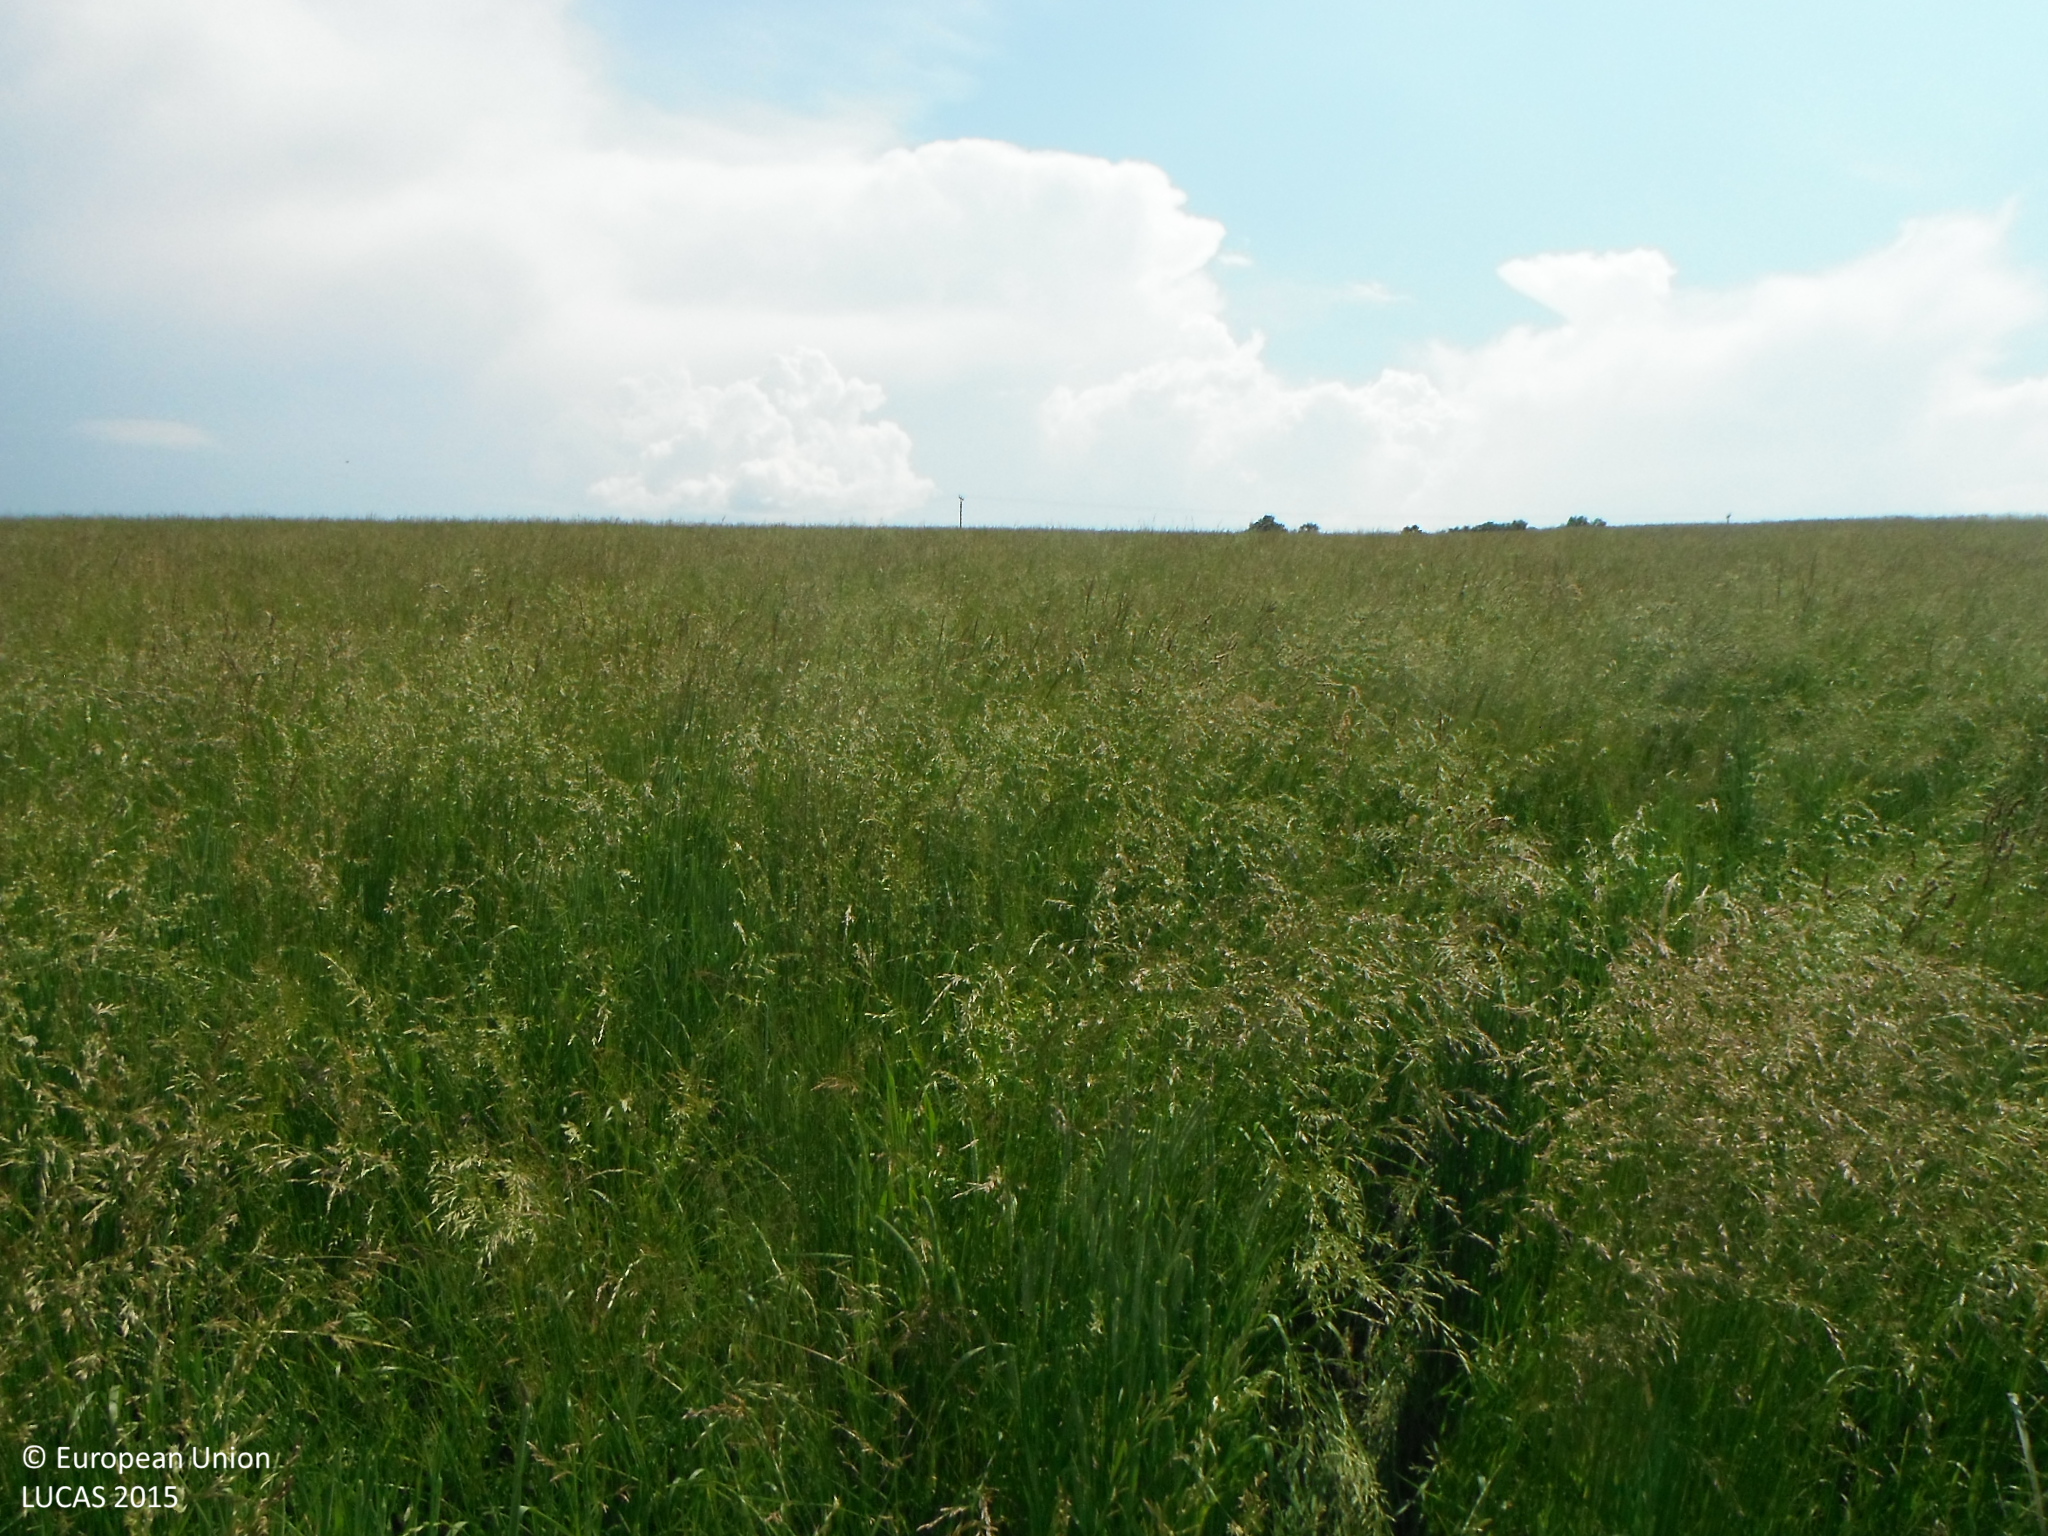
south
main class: Grassland
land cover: Grassland without tree/shrub cover
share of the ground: > 75 %
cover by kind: herbaceous plants 100 %
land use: Agriculture (excluding fallow land and kitchen gardens)
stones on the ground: < 10 %
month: June
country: SK
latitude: 48.6675
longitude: 19.2428
